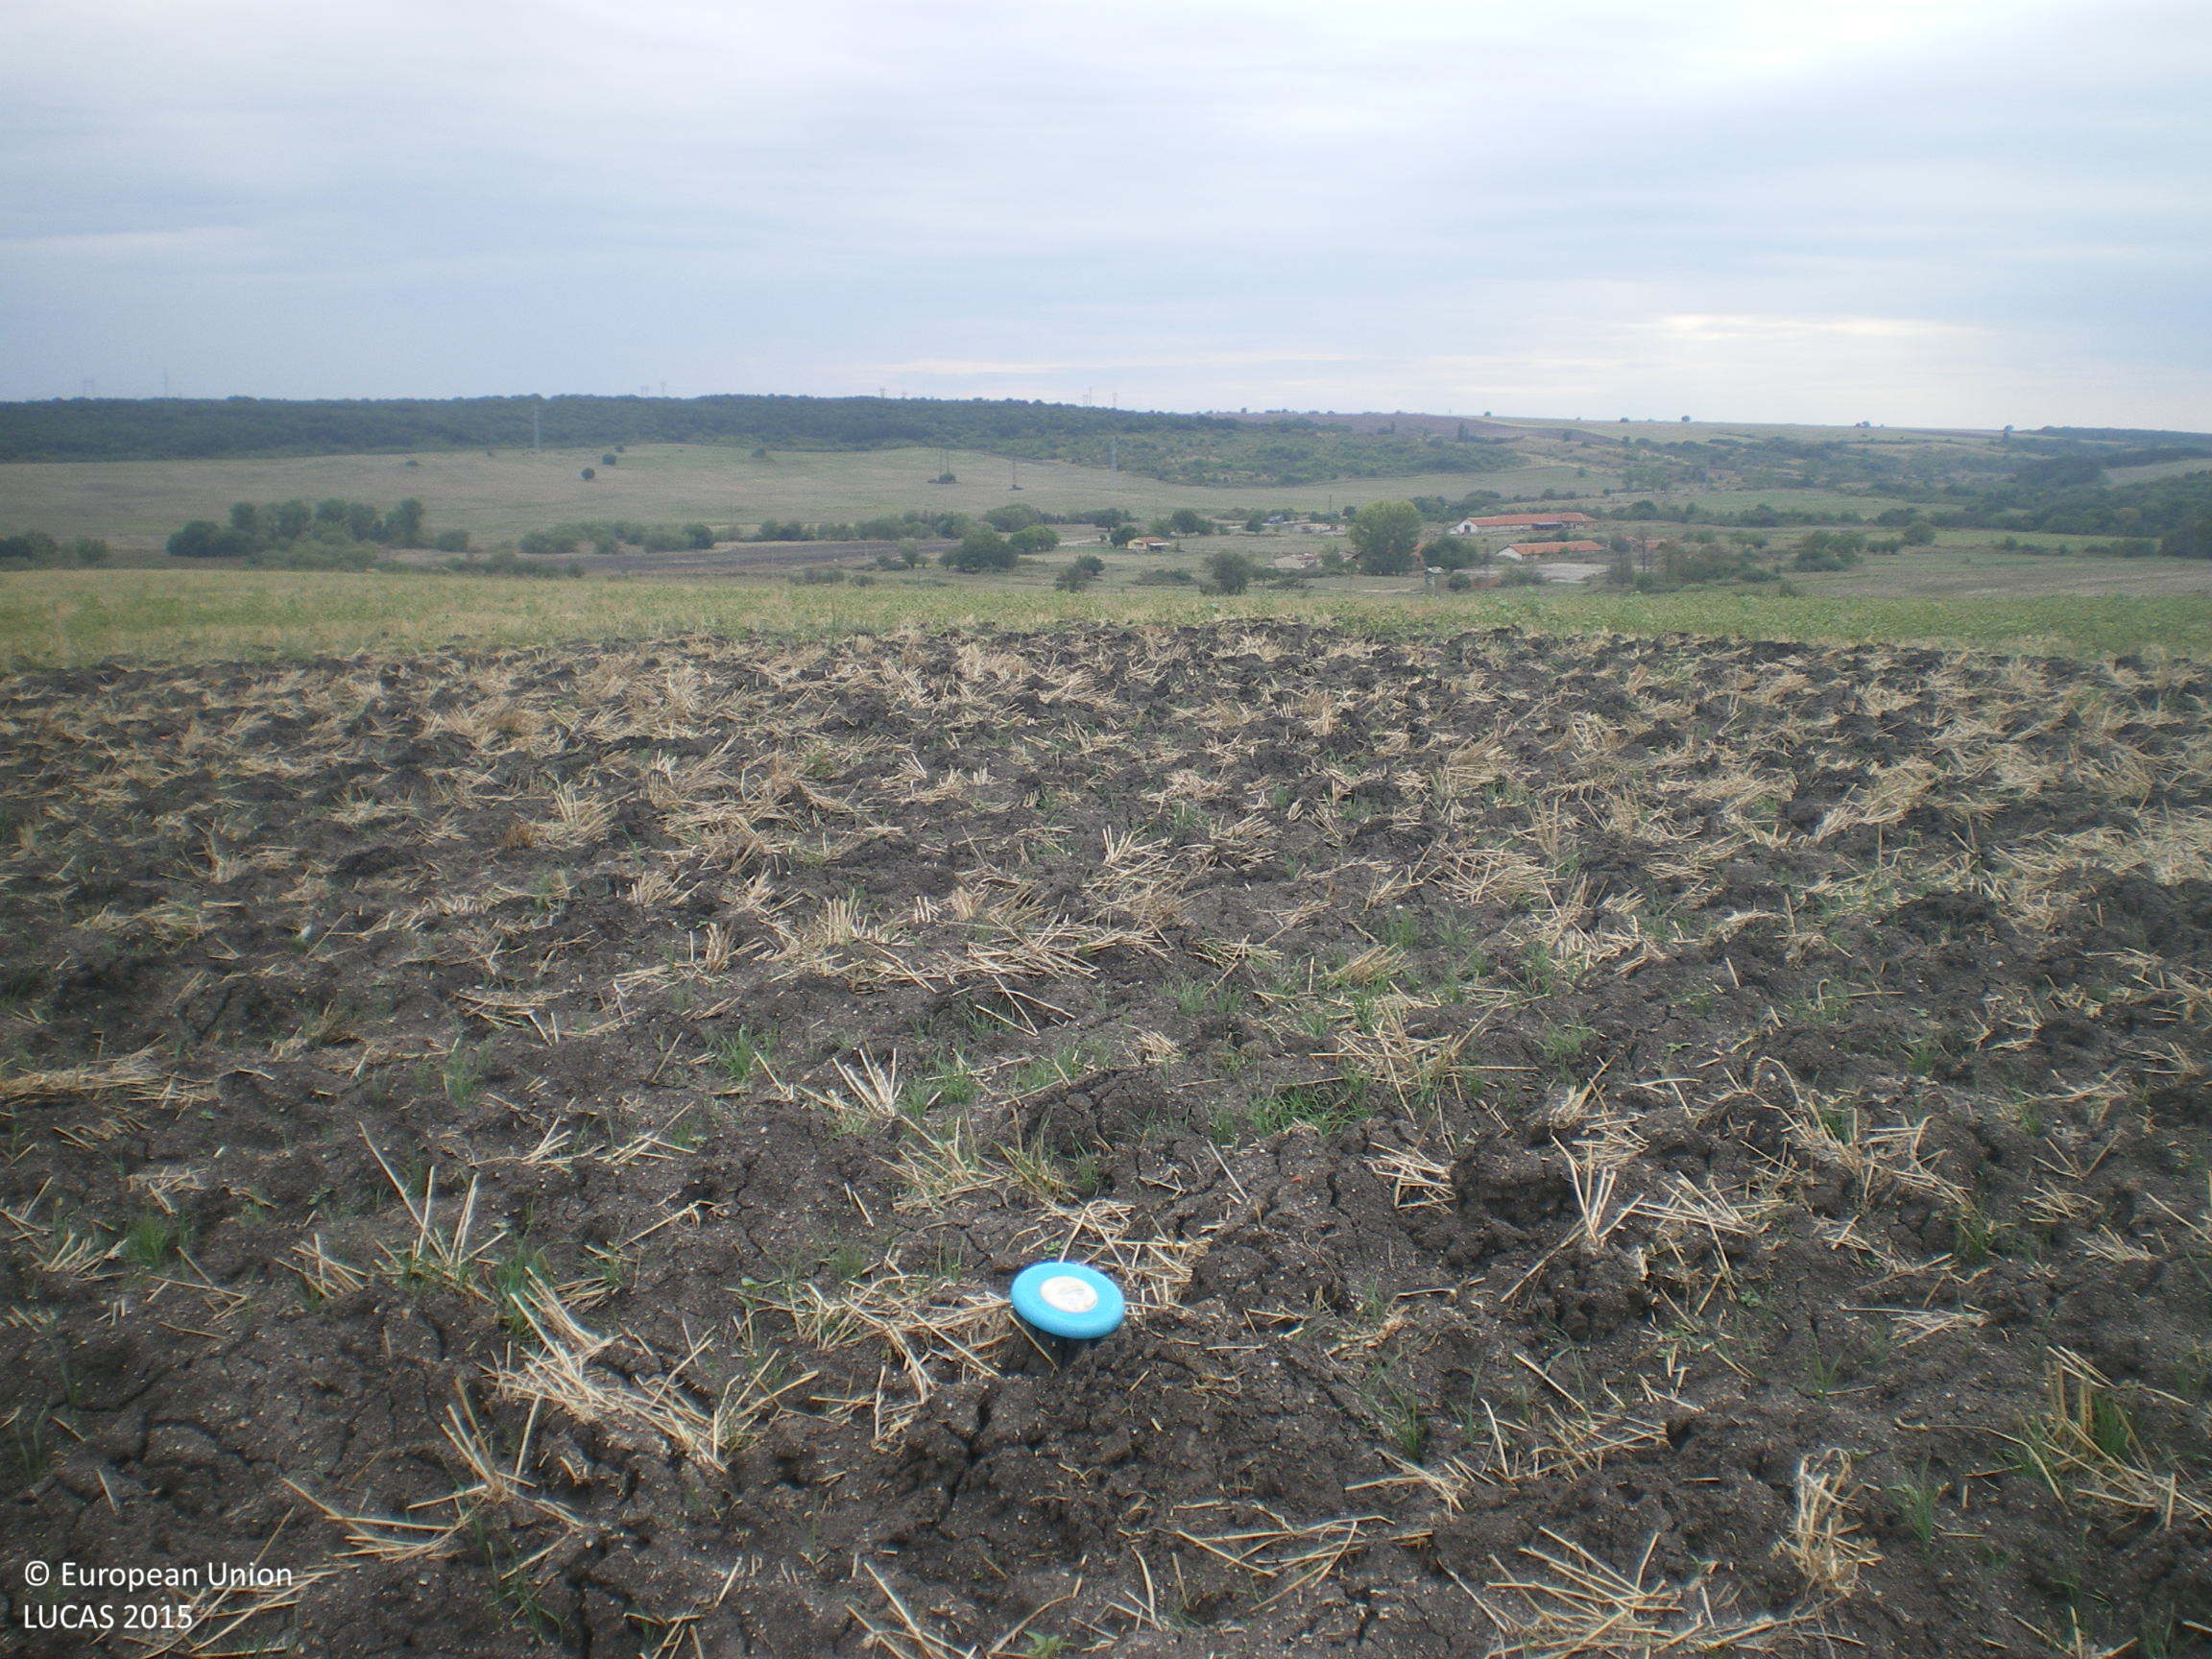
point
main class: Cropland
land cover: Common wheat
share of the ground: < 10 %
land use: Agriculture (excluding fallow land and kitchen gardens)
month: September
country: BG
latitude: 42.2041
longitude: 25.8553
